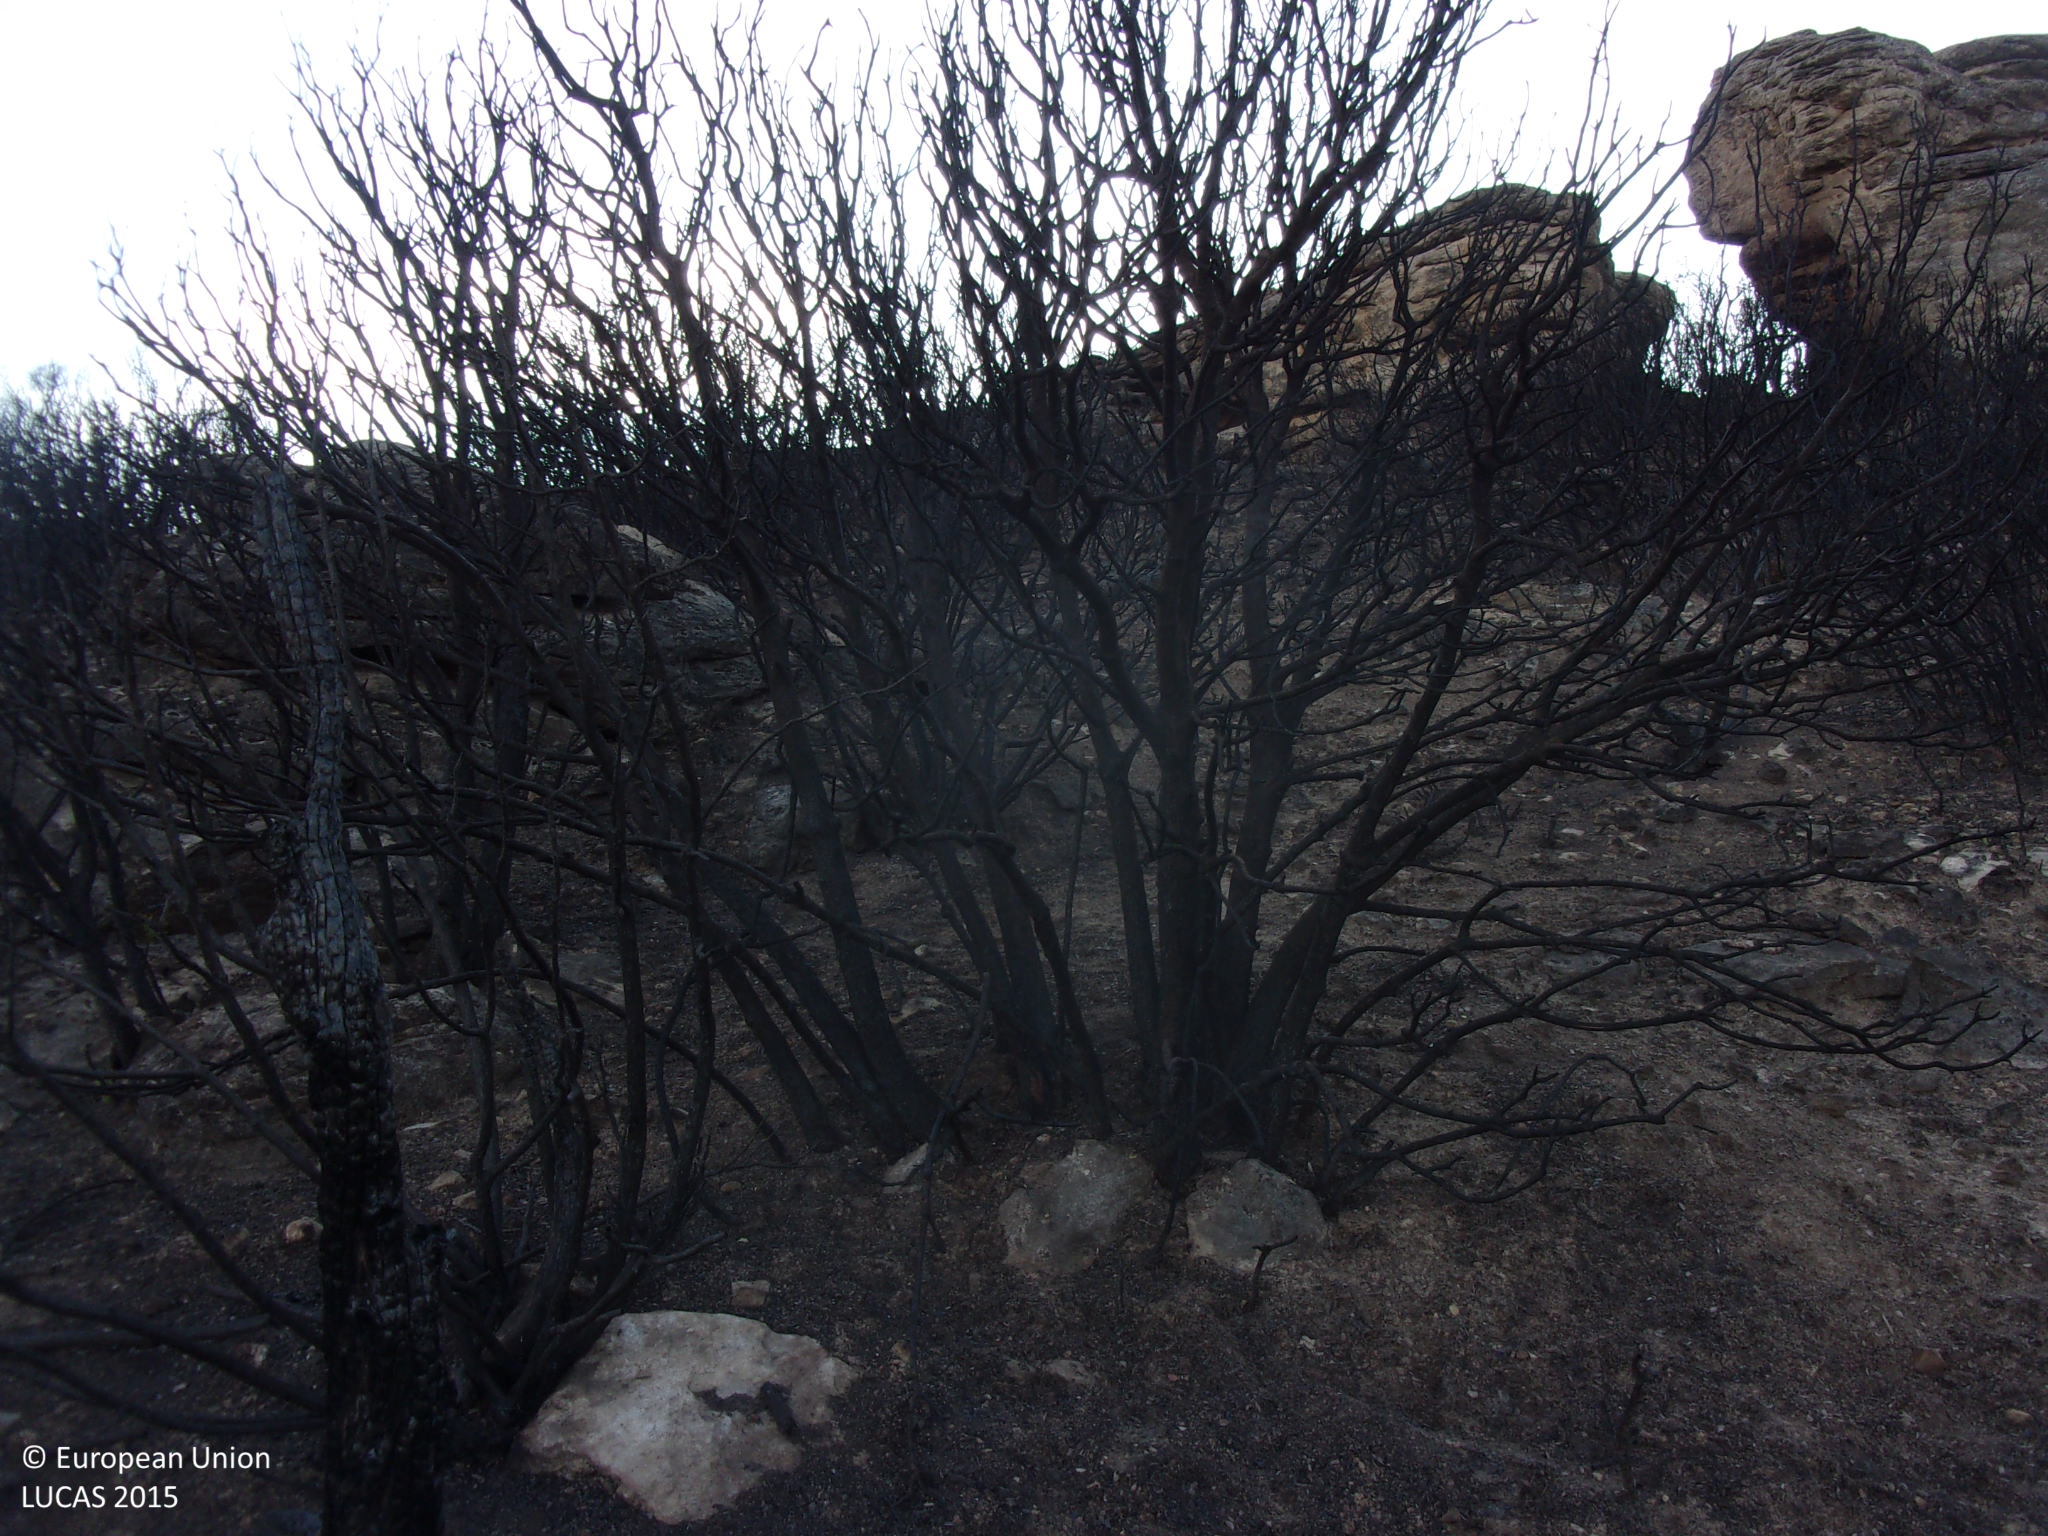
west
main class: Shrubland
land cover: Shrubland with sparse tree cover
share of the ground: 10 - 25 %
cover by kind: unconsolidated bare surface 75 %, shrubs 20 %, broadleaved forest trees 5 %
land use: Semi-natural and natural areas not in use
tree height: < 5 m
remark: Burnt area
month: August
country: ES
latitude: 42.2814
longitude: -1.0761
